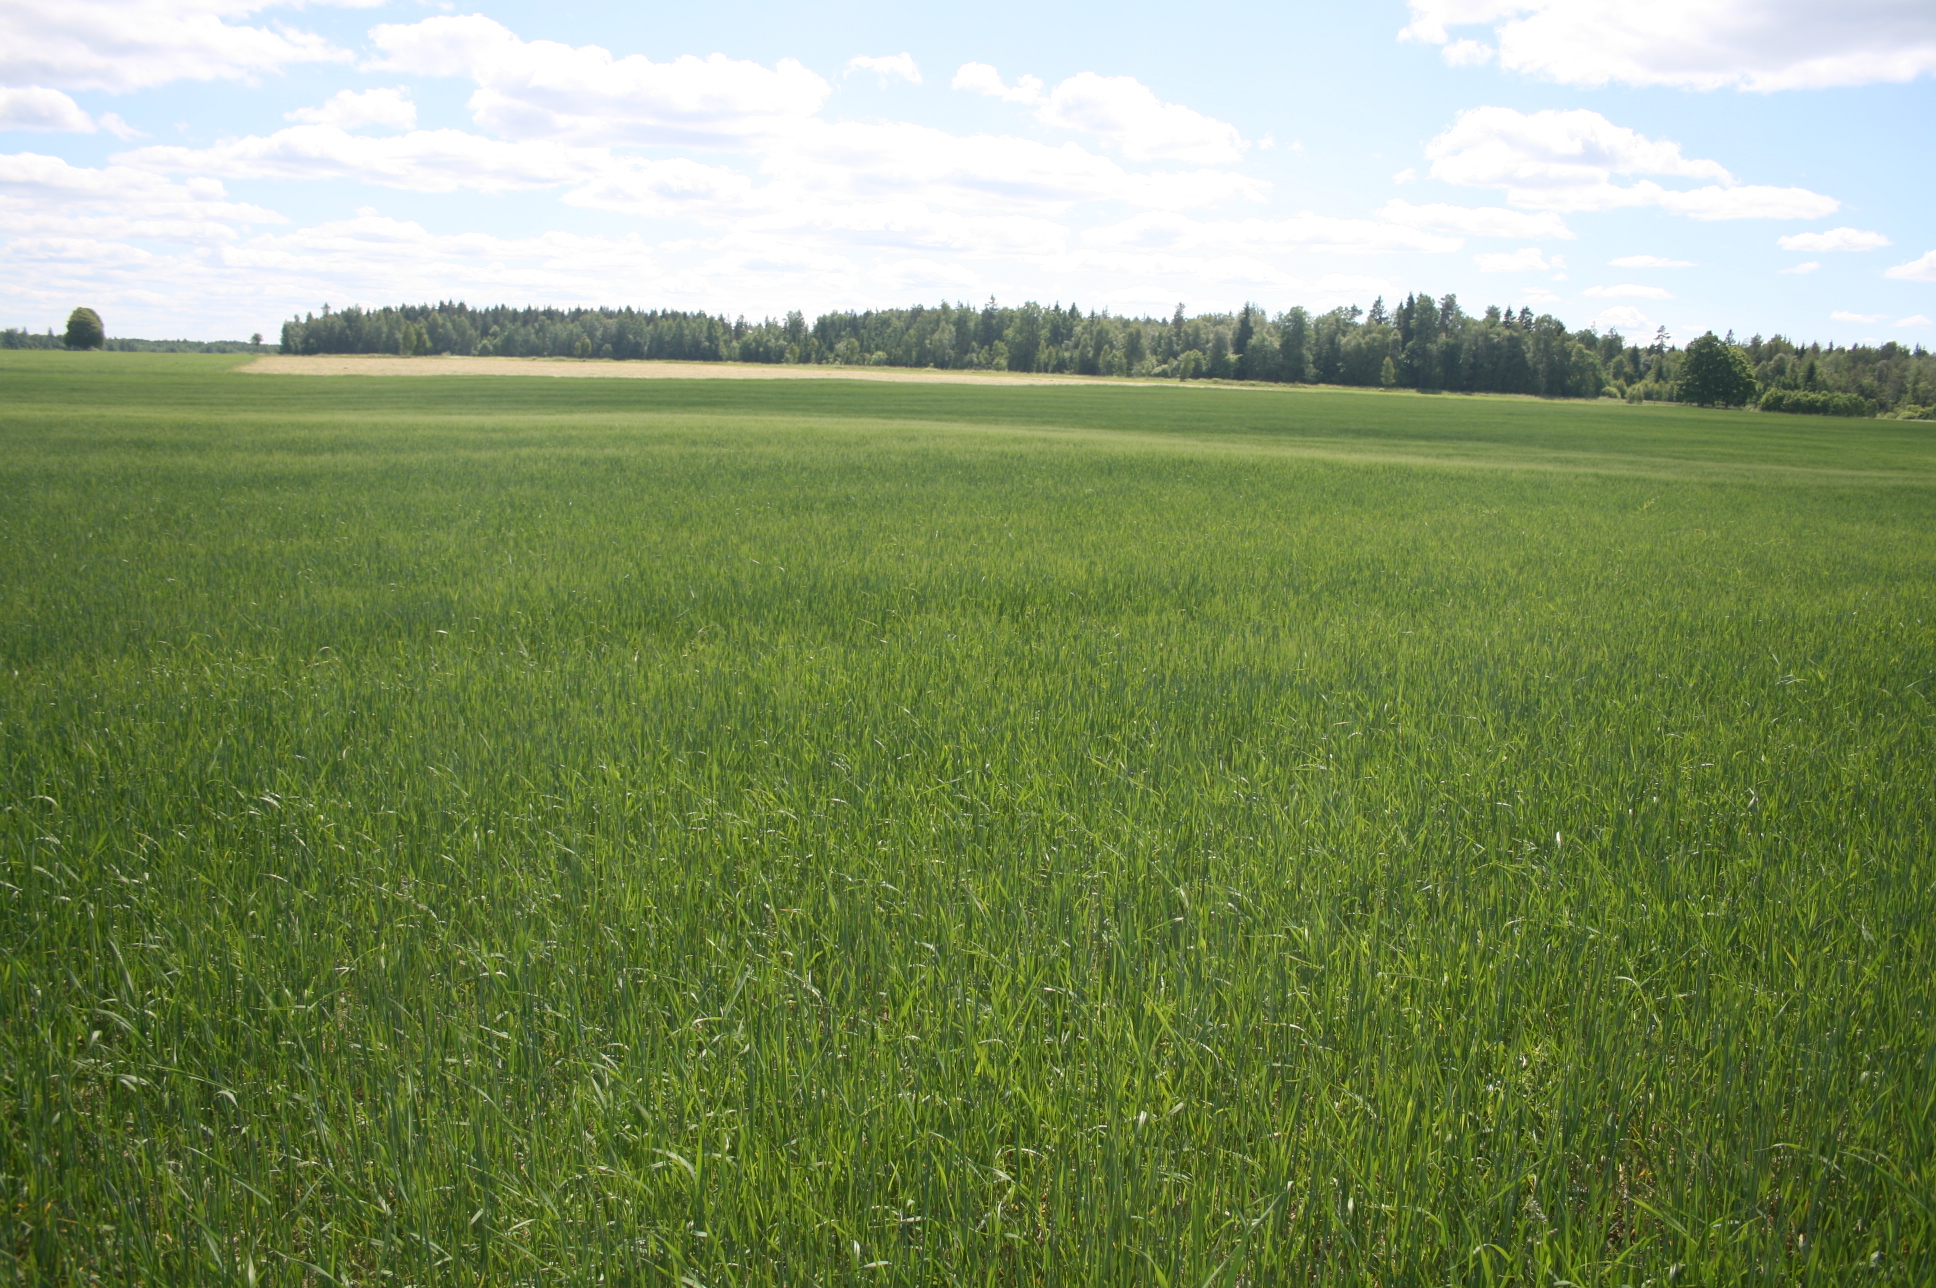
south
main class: Cropland
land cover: Barley
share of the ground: > 75 %
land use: Agriculture (excluding fallow land and kitchen gardens)
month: June
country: LT
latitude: 55.4294
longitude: 22.1123
